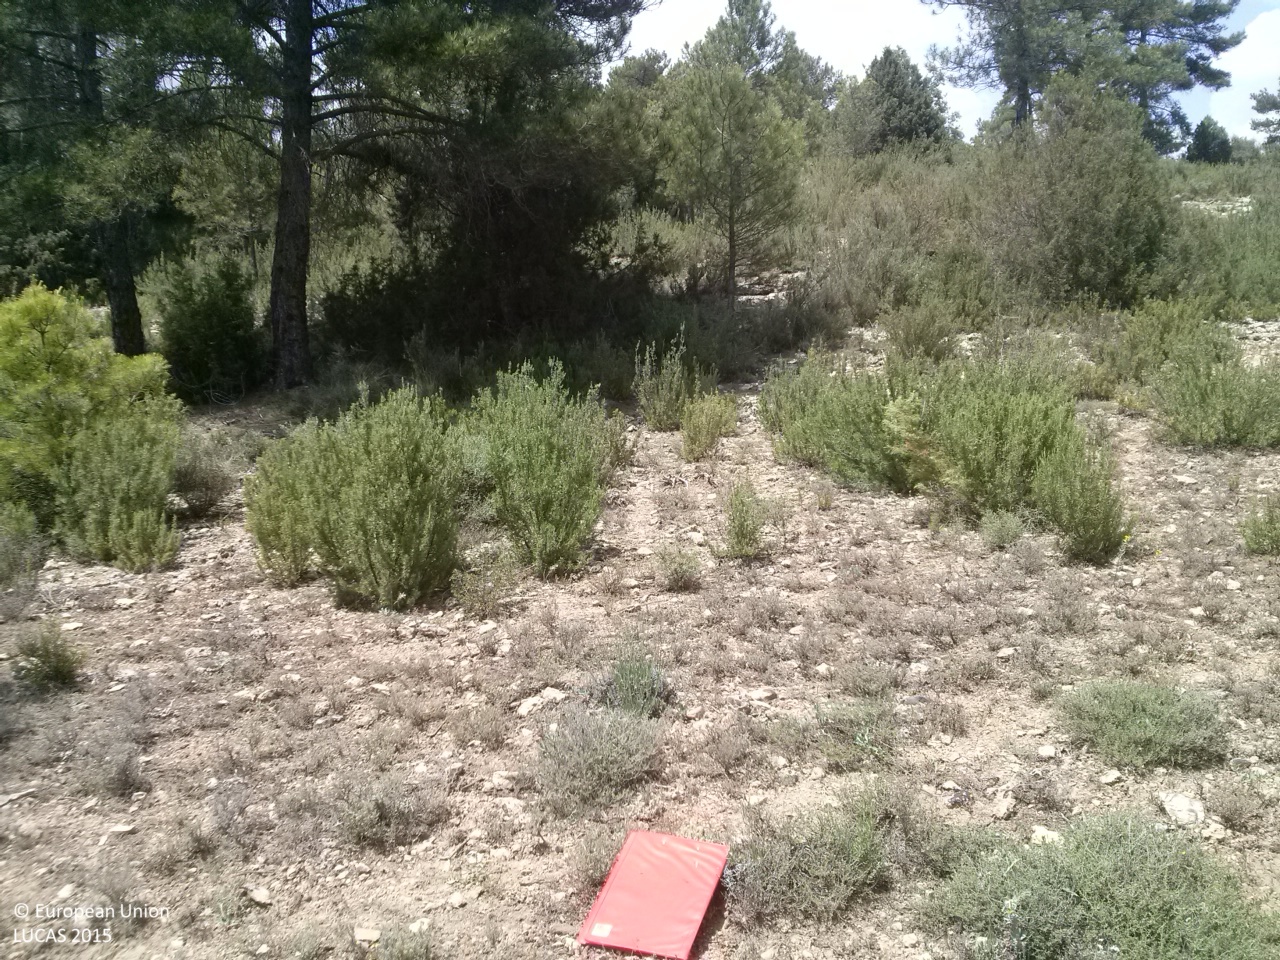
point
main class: Woodland
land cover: Pine dominated coniferous woodland
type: coniferous forest of the mediterranean region
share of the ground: 10 - 25 %
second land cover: Shrubland without tree cover
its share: 25 - 50 %
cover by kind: shrubs 50 %, herbaceous plants 30 %, coniferous forest trees 10 %, unconsolidated bare surface 10 %
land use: Forestry
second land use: Agriculture (excluding fallow land and kitchen gardens)
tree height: > 5 m
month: June
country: ES
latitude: 39.8474
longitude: -1.7793
